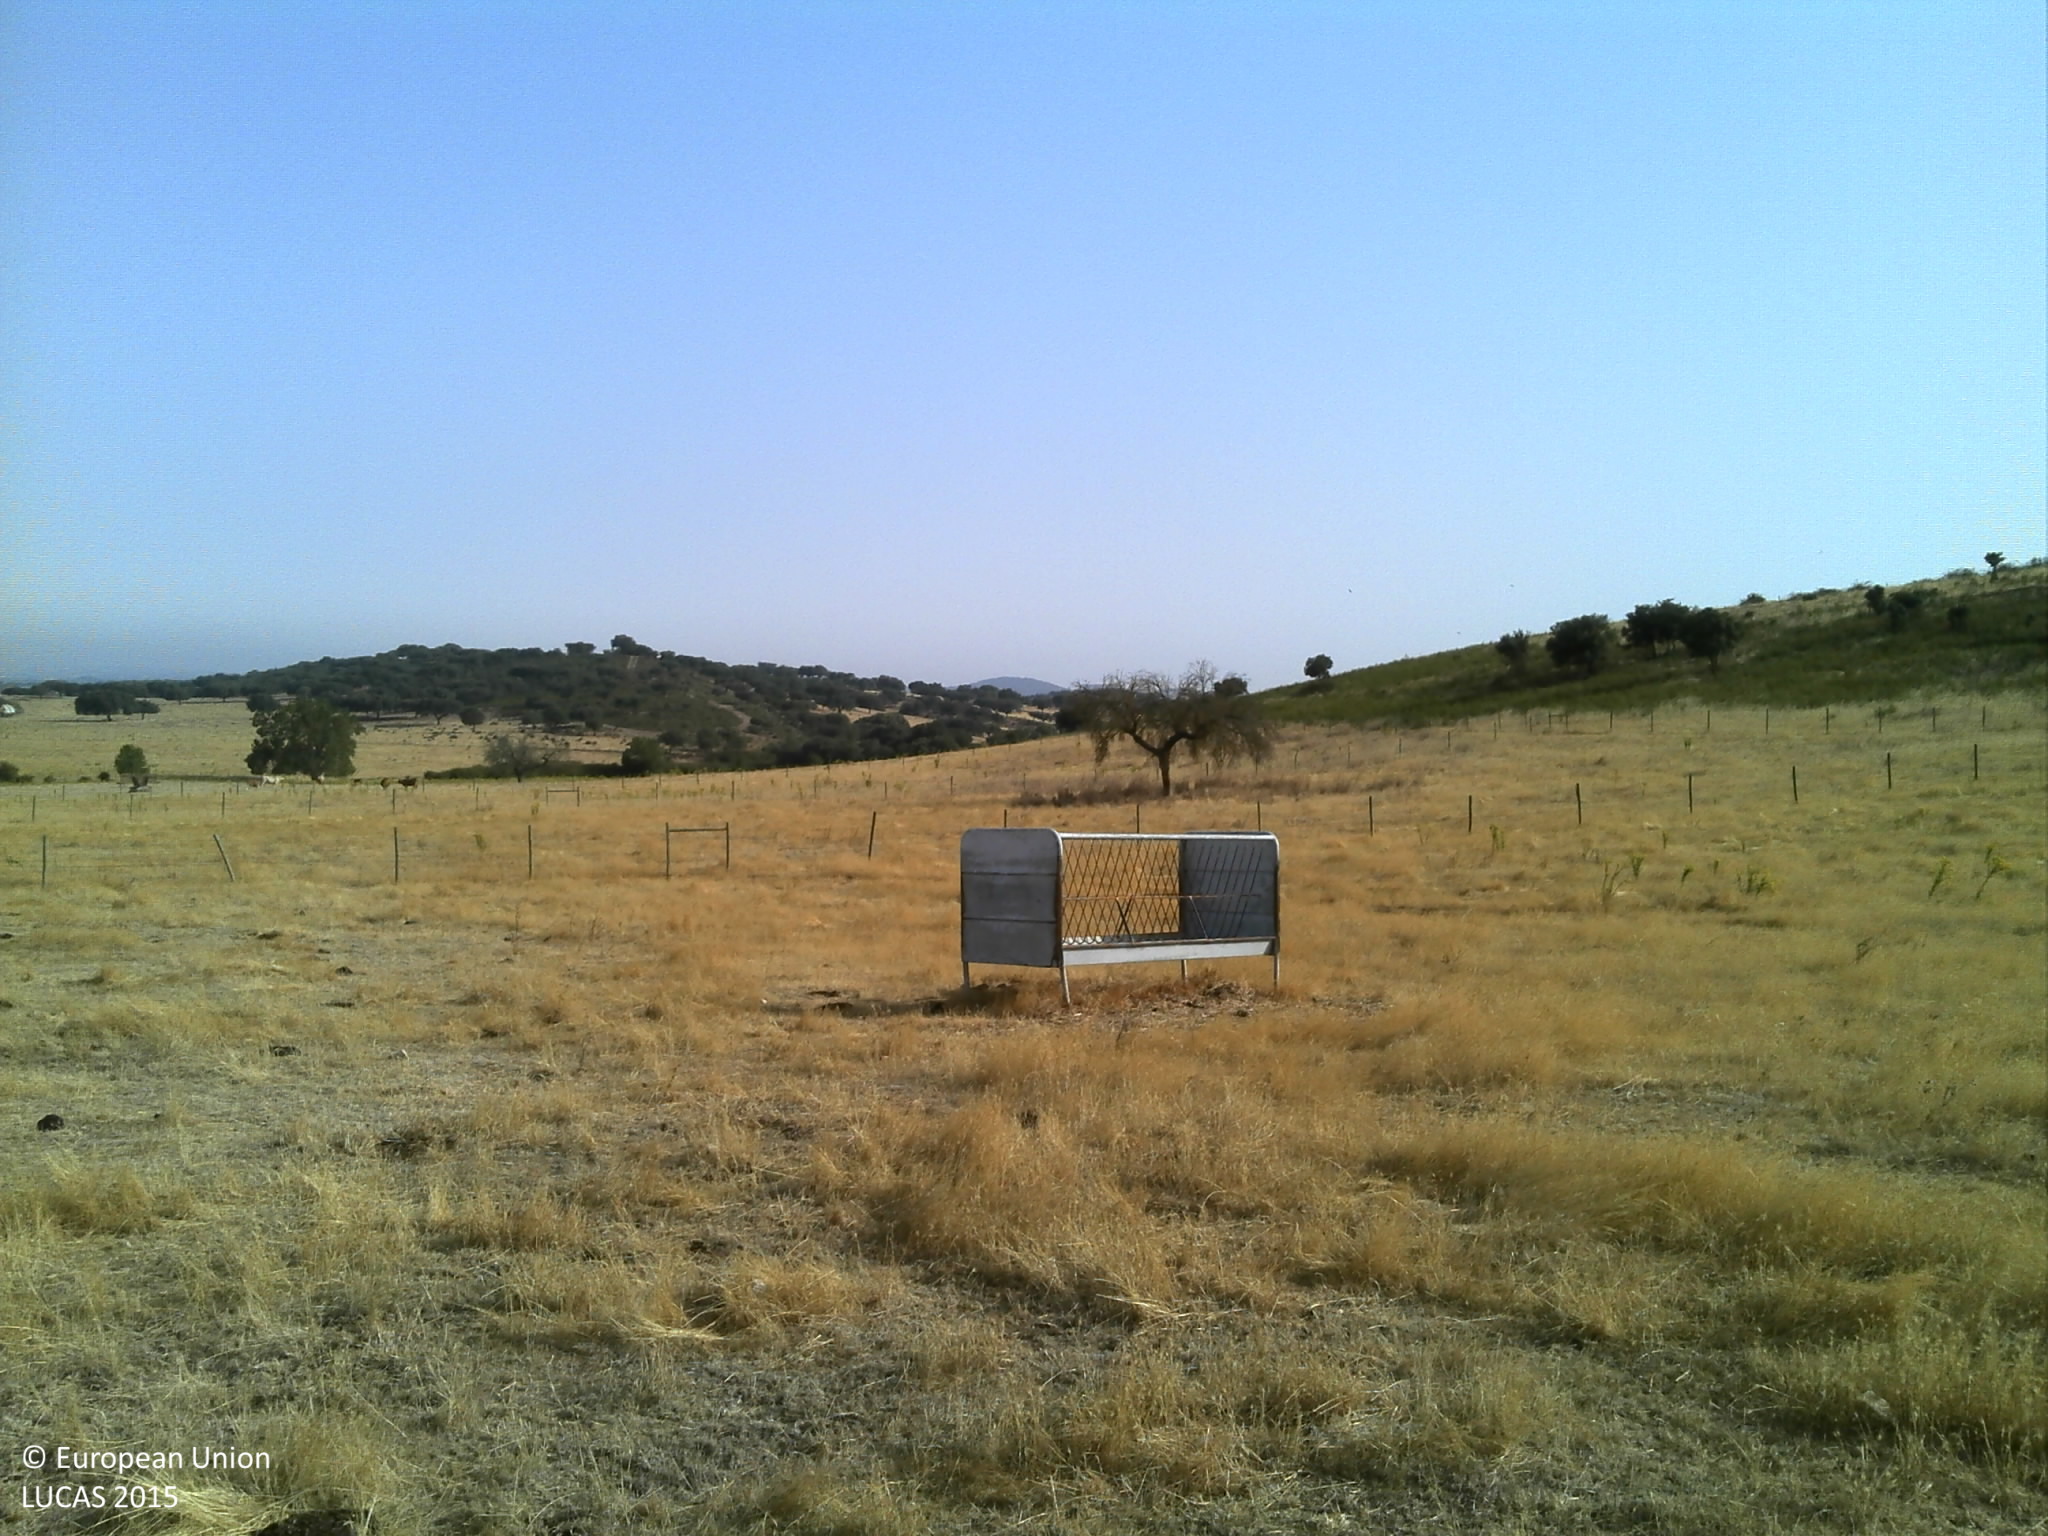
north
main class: Grassland
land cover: Grassland without tree/shrub cover
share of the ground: 25 - 50 %
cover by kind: unconsolidated bare surface 60 %, herbaceous plants 40 %
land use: Agriculture (excluding fallow land and kitchen gardens)
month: July
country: PT
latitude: 38.7077
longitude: -7.4531
